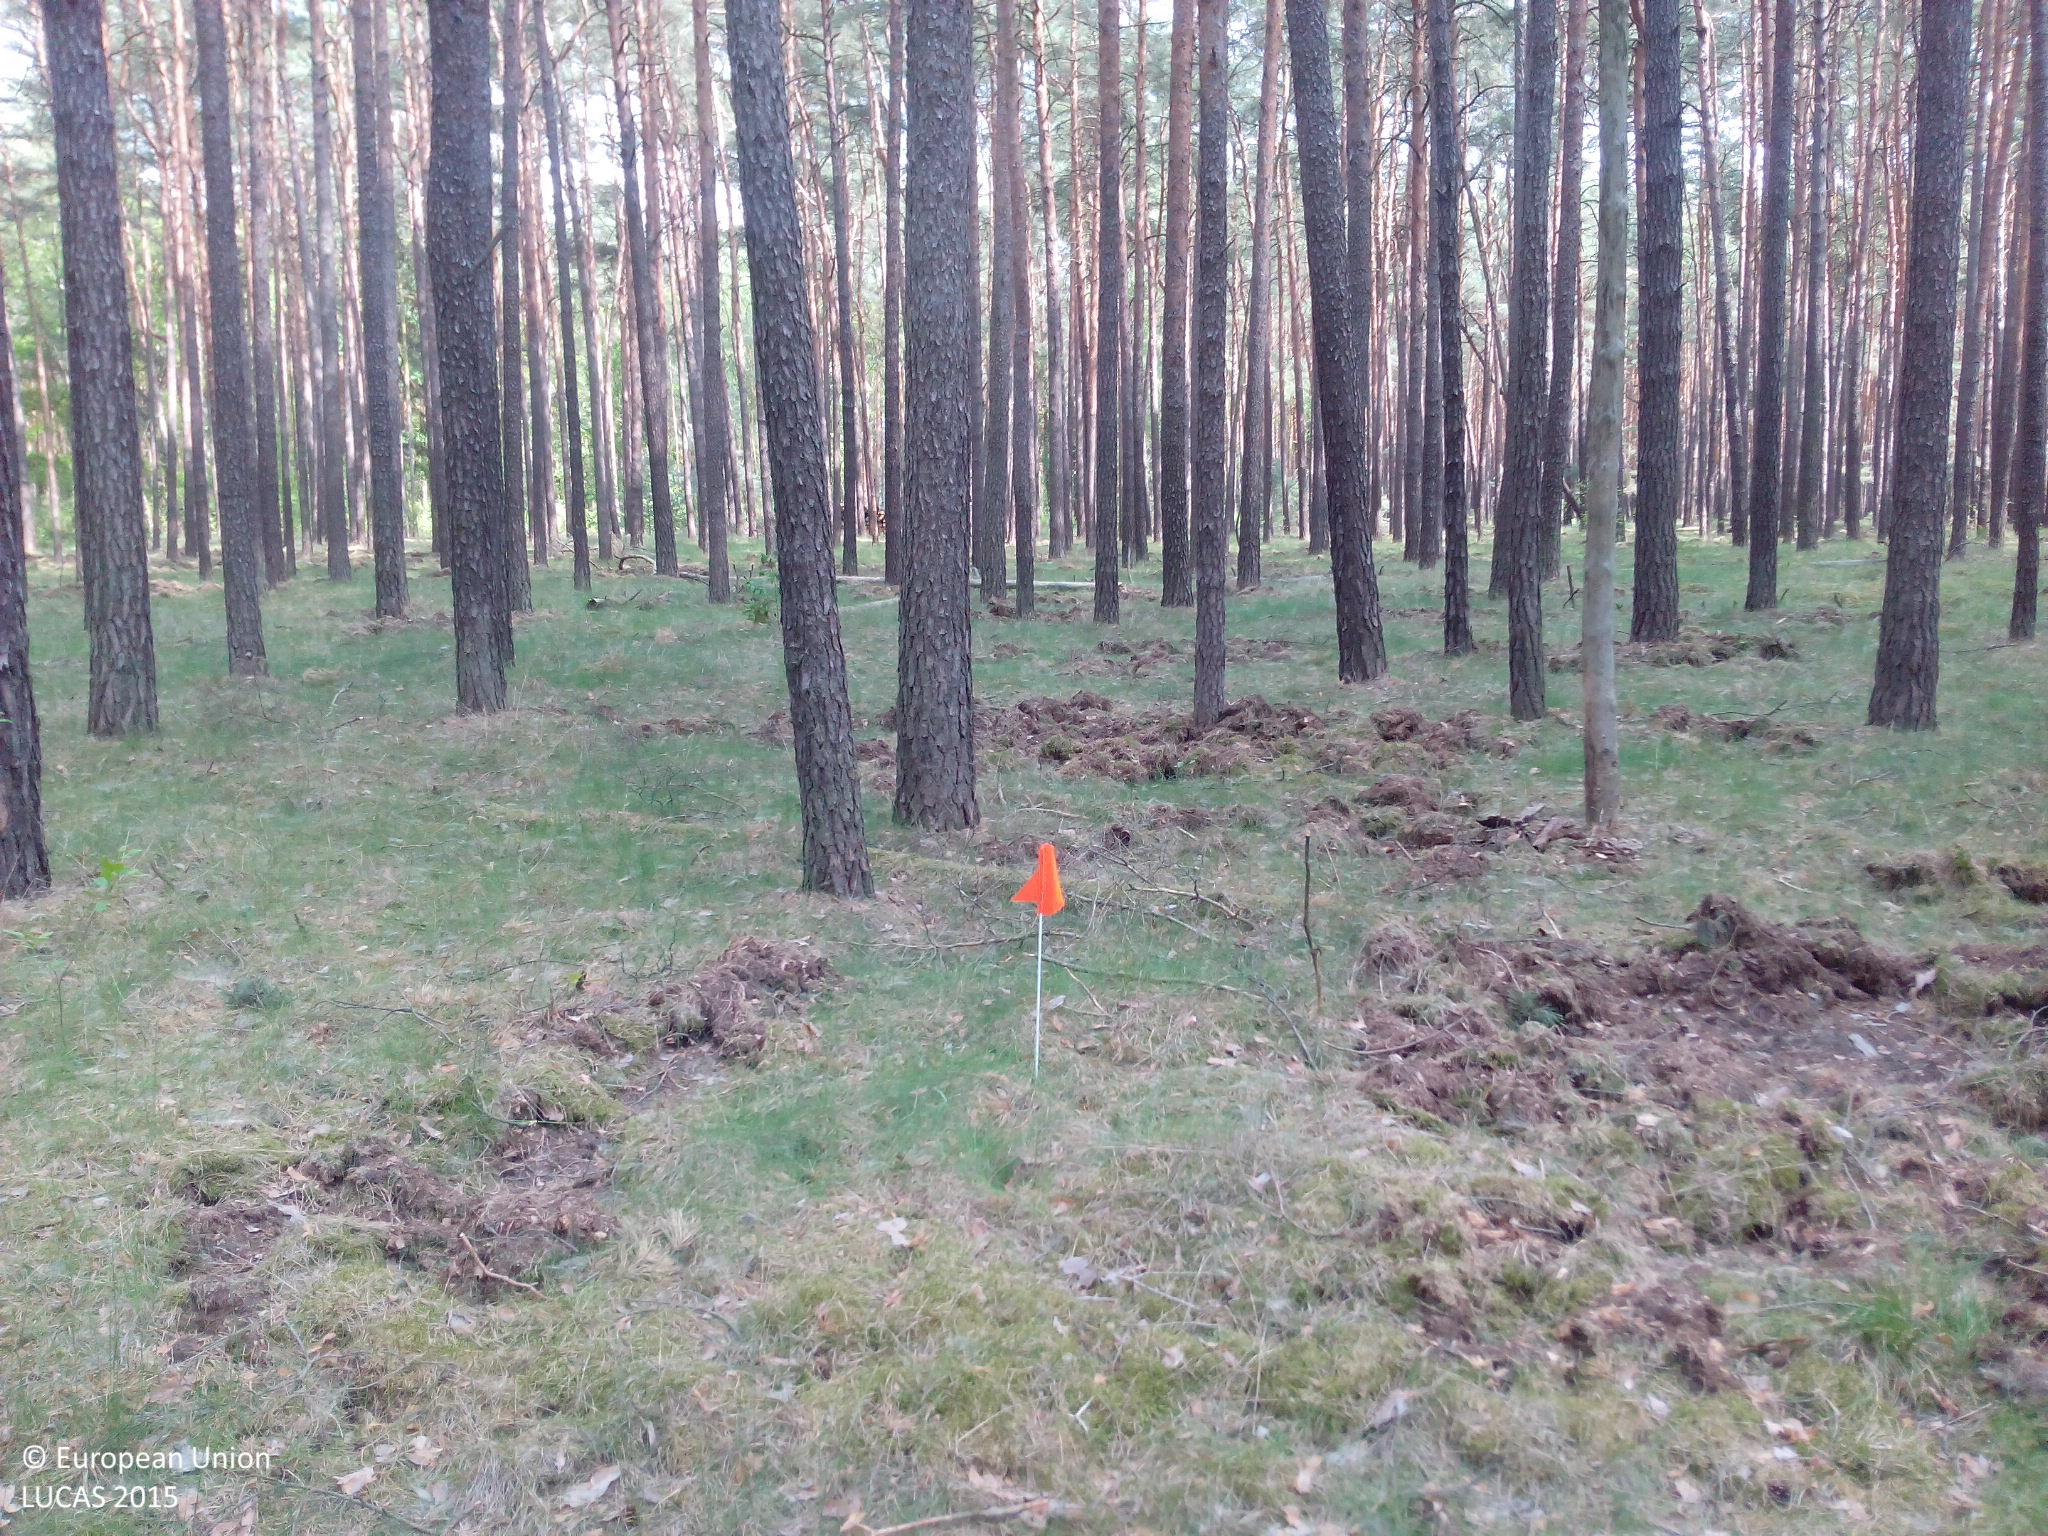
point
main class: Woodland
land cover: Pine dominated coniferous woodland
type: hemiboreal forest and nemoral coniferous forest and mixed broadleaved-coniferous forest
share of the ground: > 75 %
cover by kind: coniferous forest trees 80 %, herbaceous plants 10 %, lichens and mosses 5 %, unconsolidated bare surface 5 %
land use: Forestry
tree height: > 5 m
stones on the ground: < 10 %
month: May
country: DE
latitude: 52.1373
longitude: 13.1705
